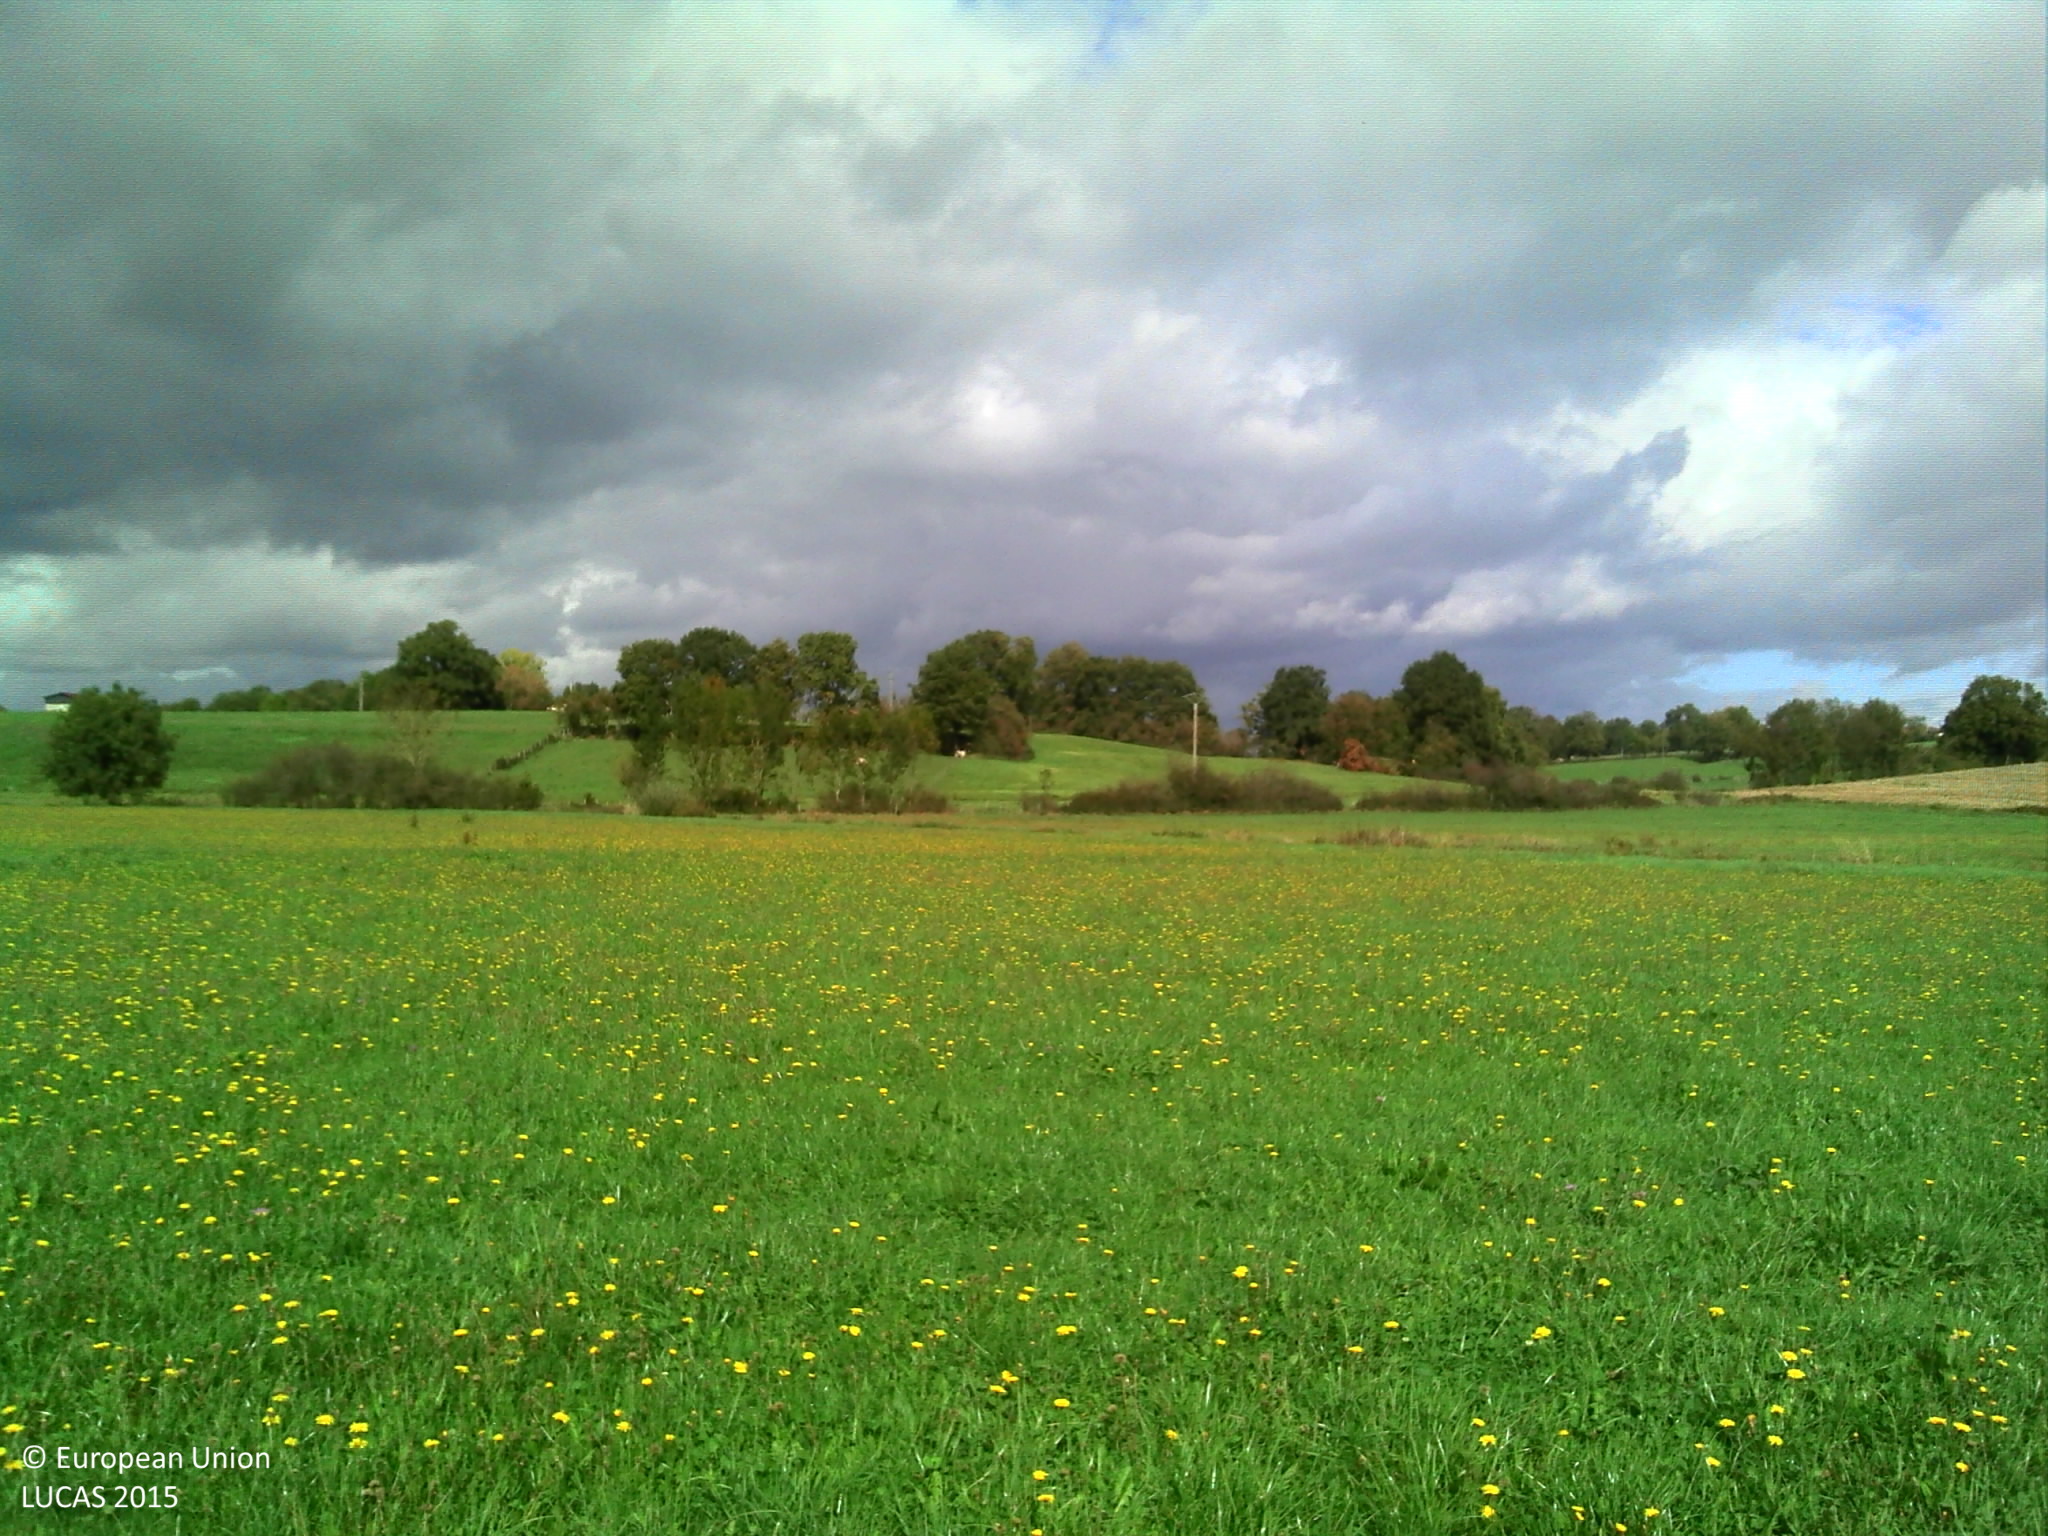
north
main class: Grassland
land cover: Grassland without tree/shrub cover
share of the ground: > 75 %
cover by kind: herbaceous plants 100 %
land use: Agriculture (excluding fallow land and kitchen gardens)
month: October
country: FR
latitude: 46.3903
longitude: 5.2561
